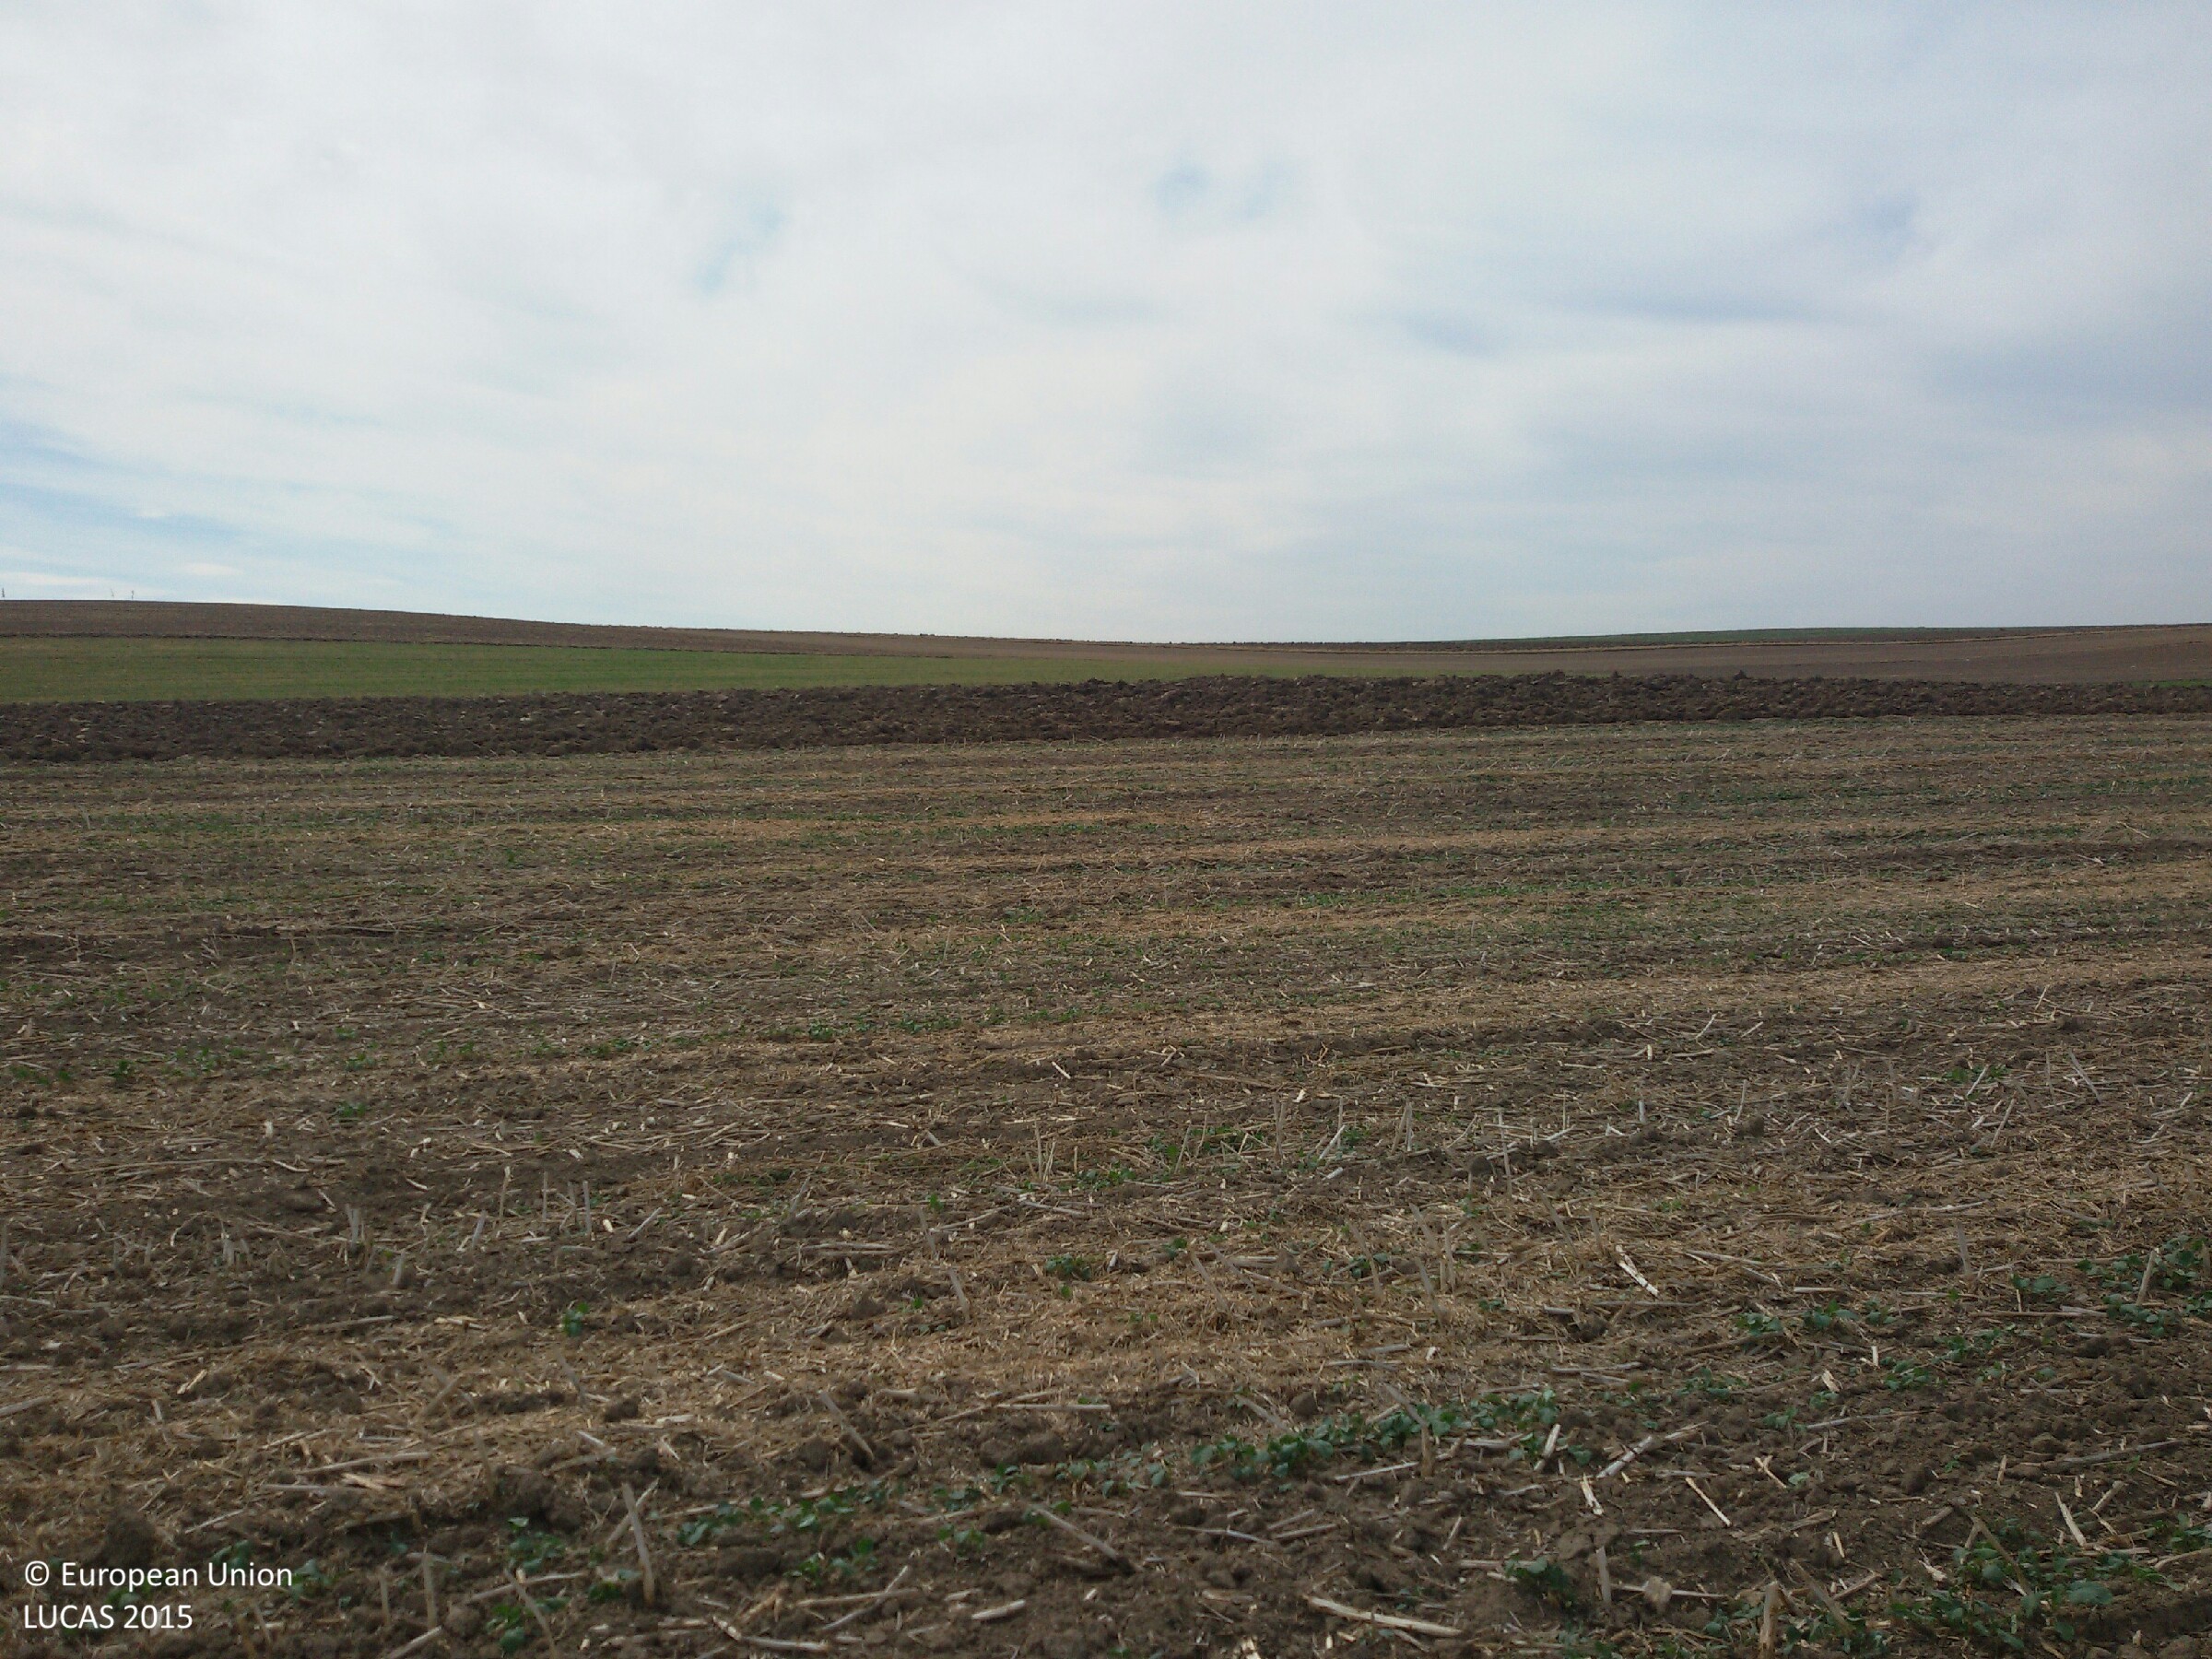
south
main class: Cropland
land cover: Rape and turnip rape
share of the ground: 25 - 50 %
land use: Agriculture (excluding fallow land and kitchen gardens)
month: August
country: PL
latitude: 53.9815
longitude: 19.3417
